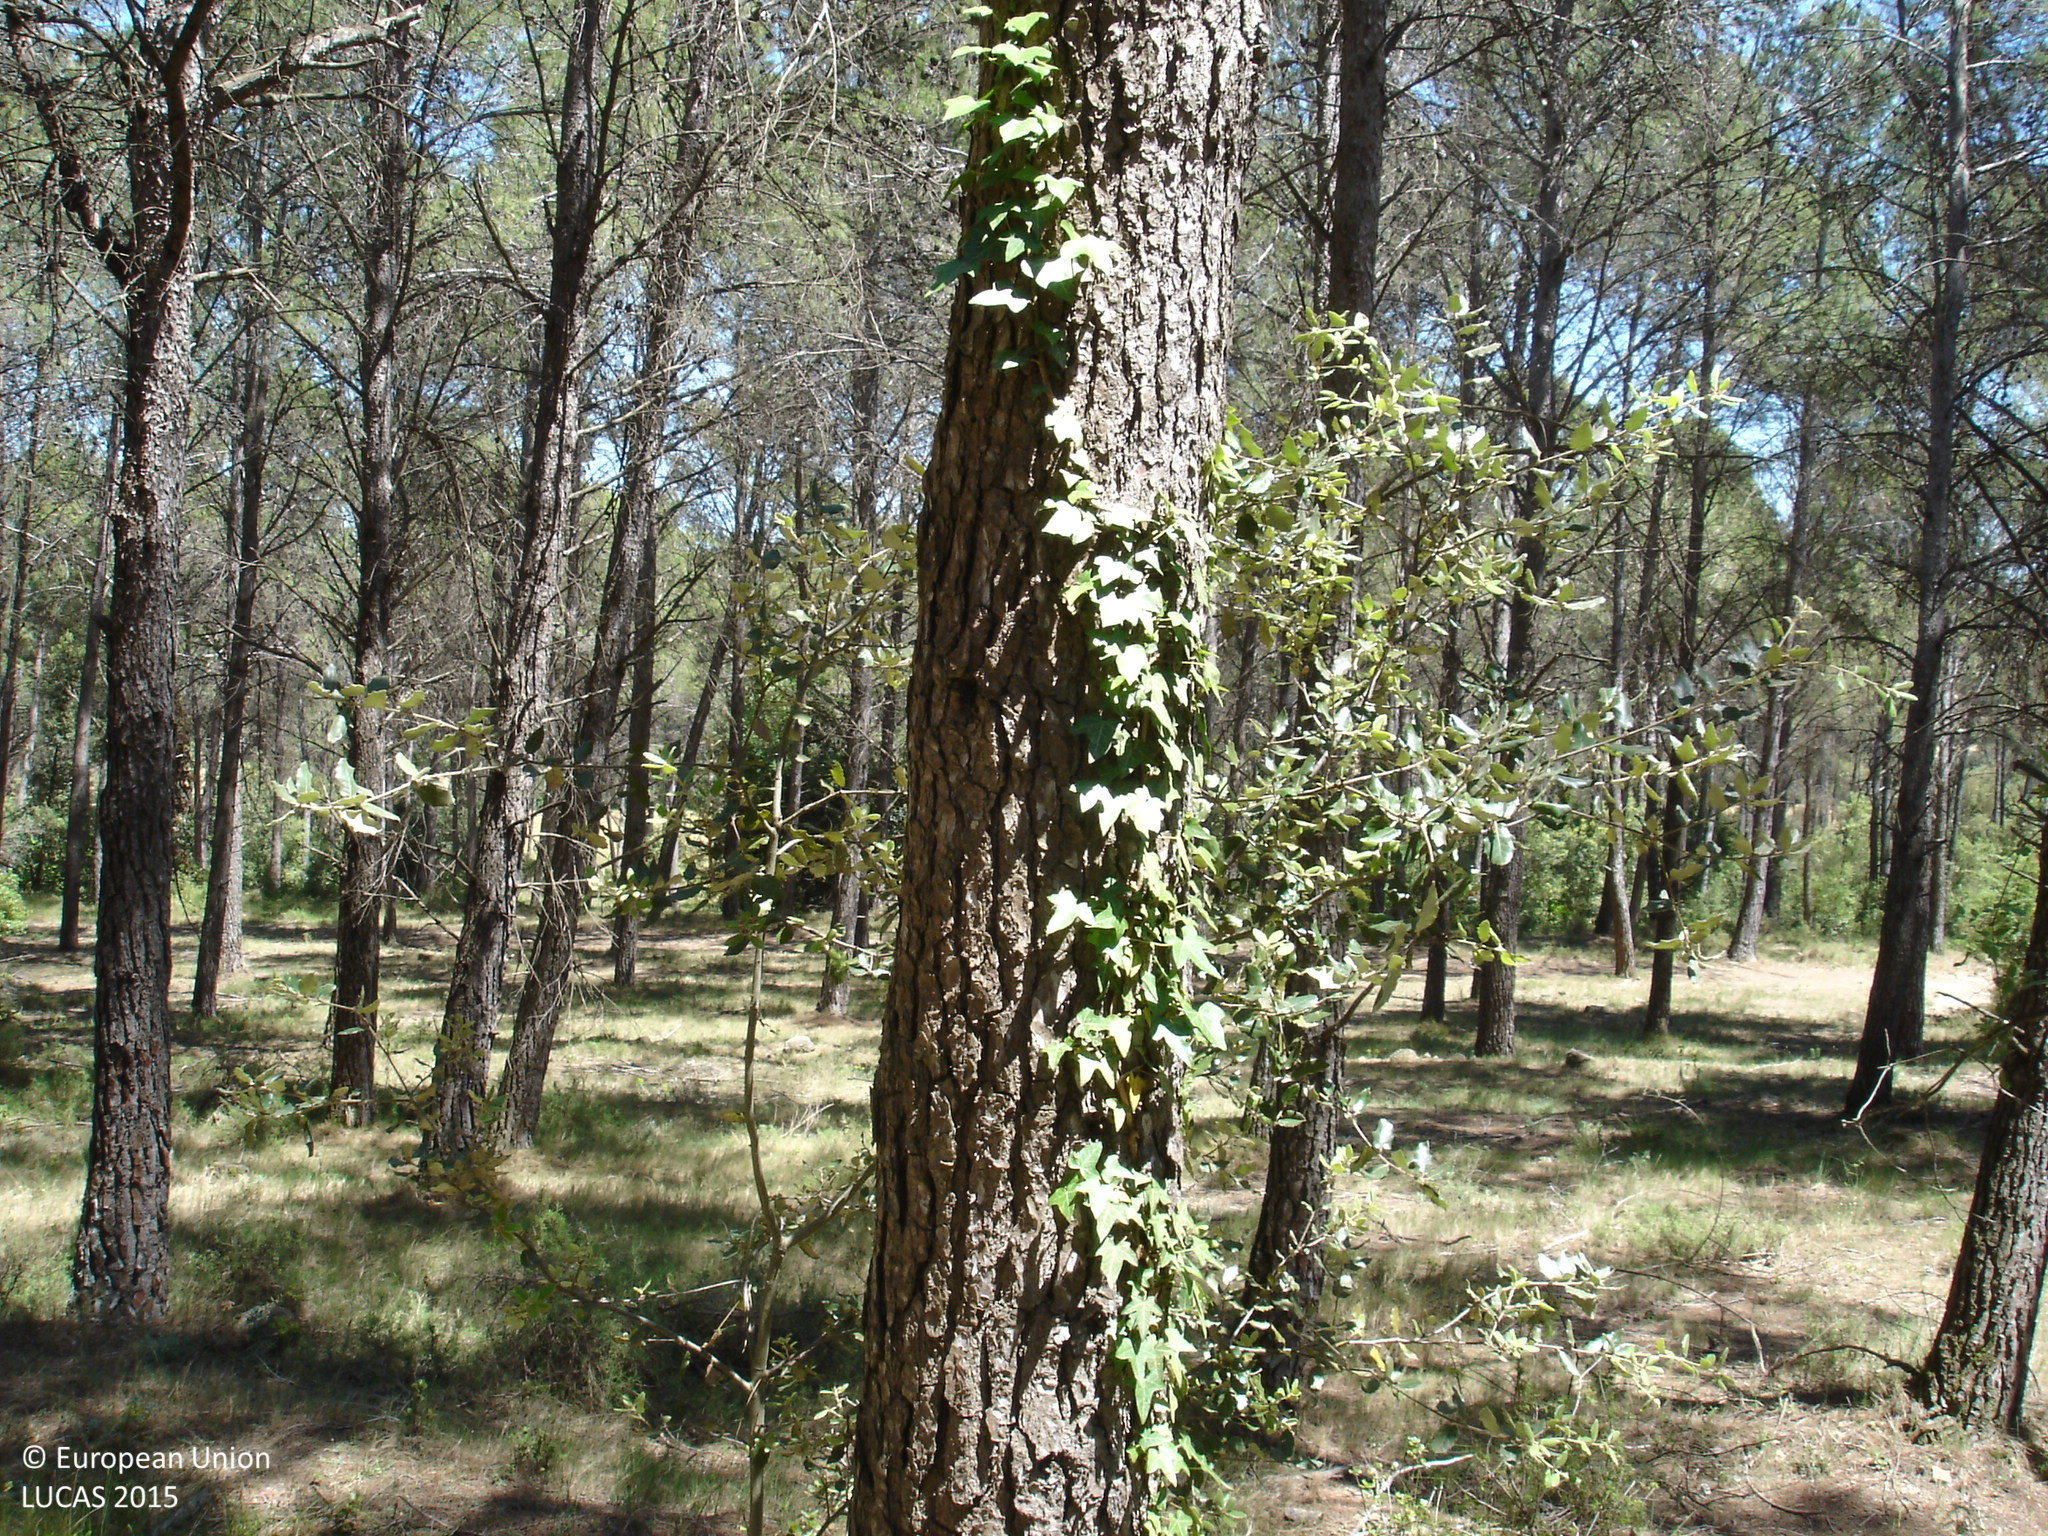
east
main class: Woodland
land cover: Pine dominated coniferous woodland
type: coniferous forest of the mediterranean region
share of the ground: > 75 %
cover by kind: coniferous forest trees 80 %, herbaceous plants 10 %, broadleaved forest trees 5 %, shrubs 5 %
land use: Forestry
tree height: > 5 m
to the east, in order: Pine dominated coniferous woodland; Tracks; Pine dominated coniferous woodland; Grass margins; Tracks; Pine dominated coniferous woodland; Durum wheat; Groves
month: May
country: ES
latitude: 42.0865
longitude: 3.0156
